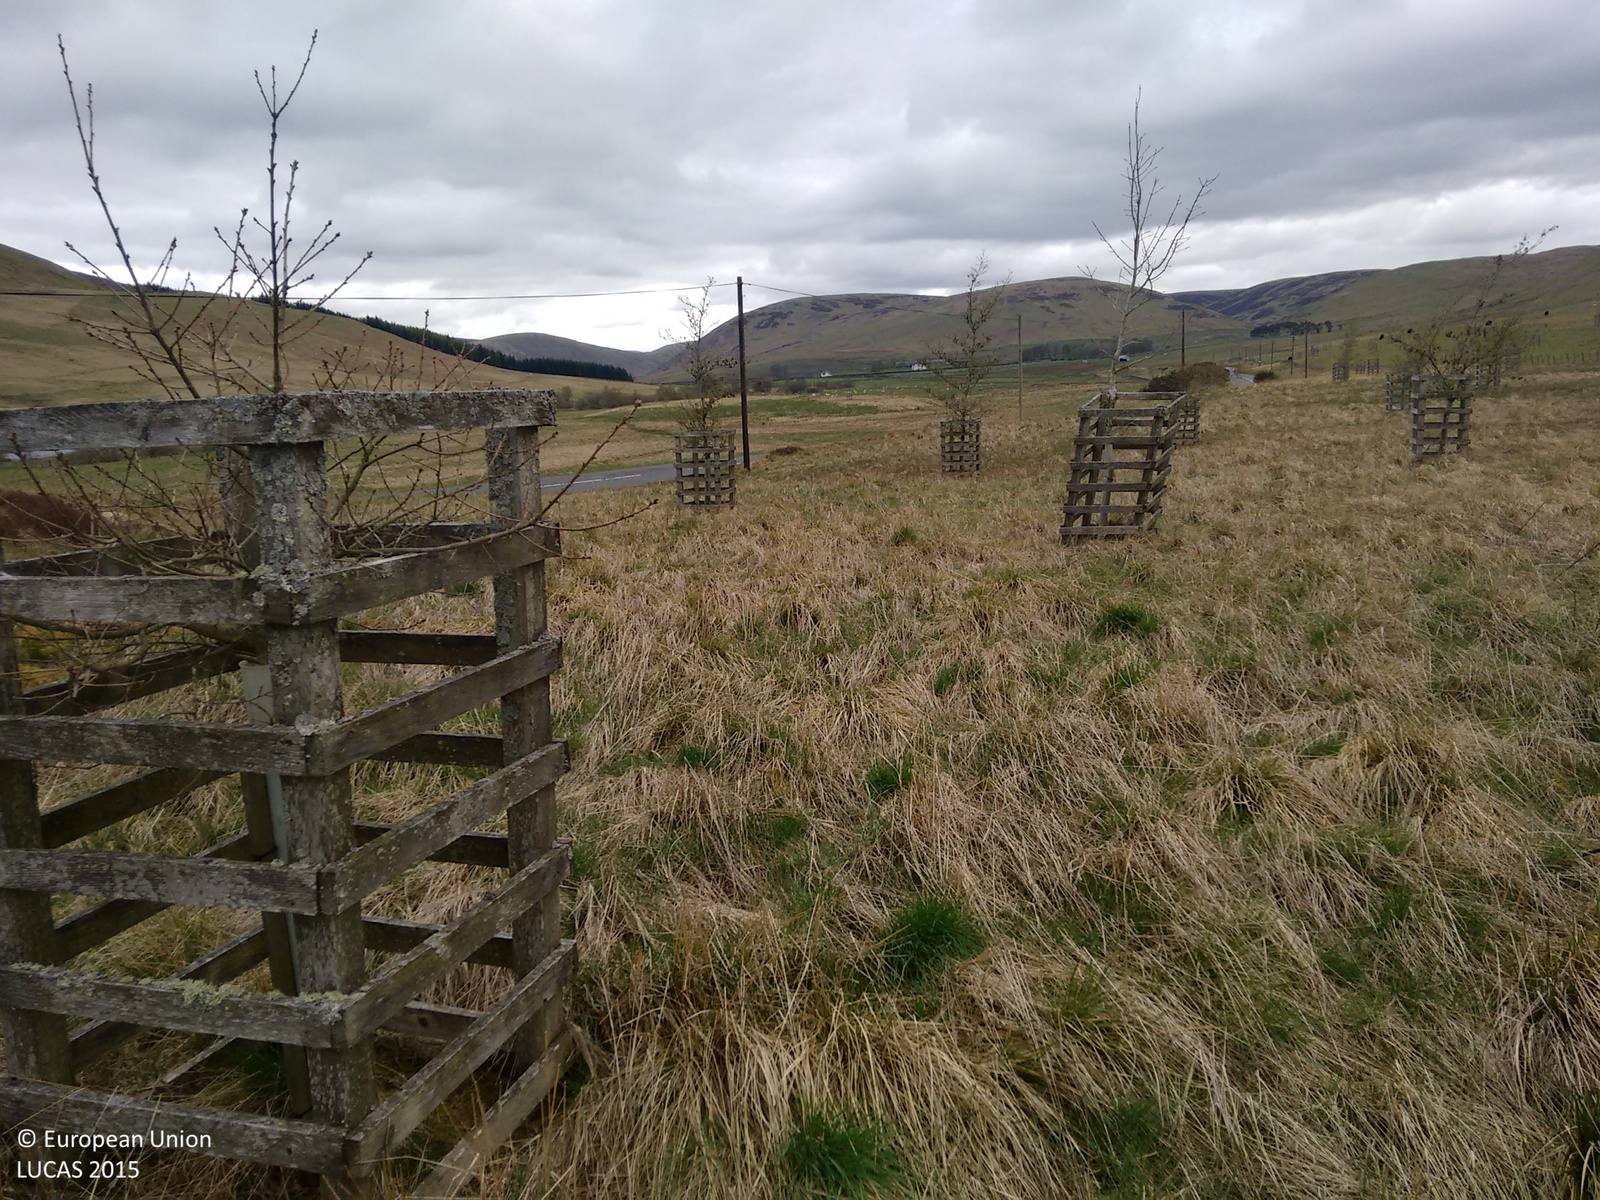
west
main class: Grassland
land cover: Grassland with sparse tree/shrub cover
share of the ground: > 75 %
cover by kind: herbaceous plants 90 %, broadleaved forest trees 5 %, shrubs 5 %
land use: Agriculture (excluding fallow land and kitchen gardens)
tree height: < 5 m
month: May
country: GB
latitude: 55.5087
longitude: -3.1353
